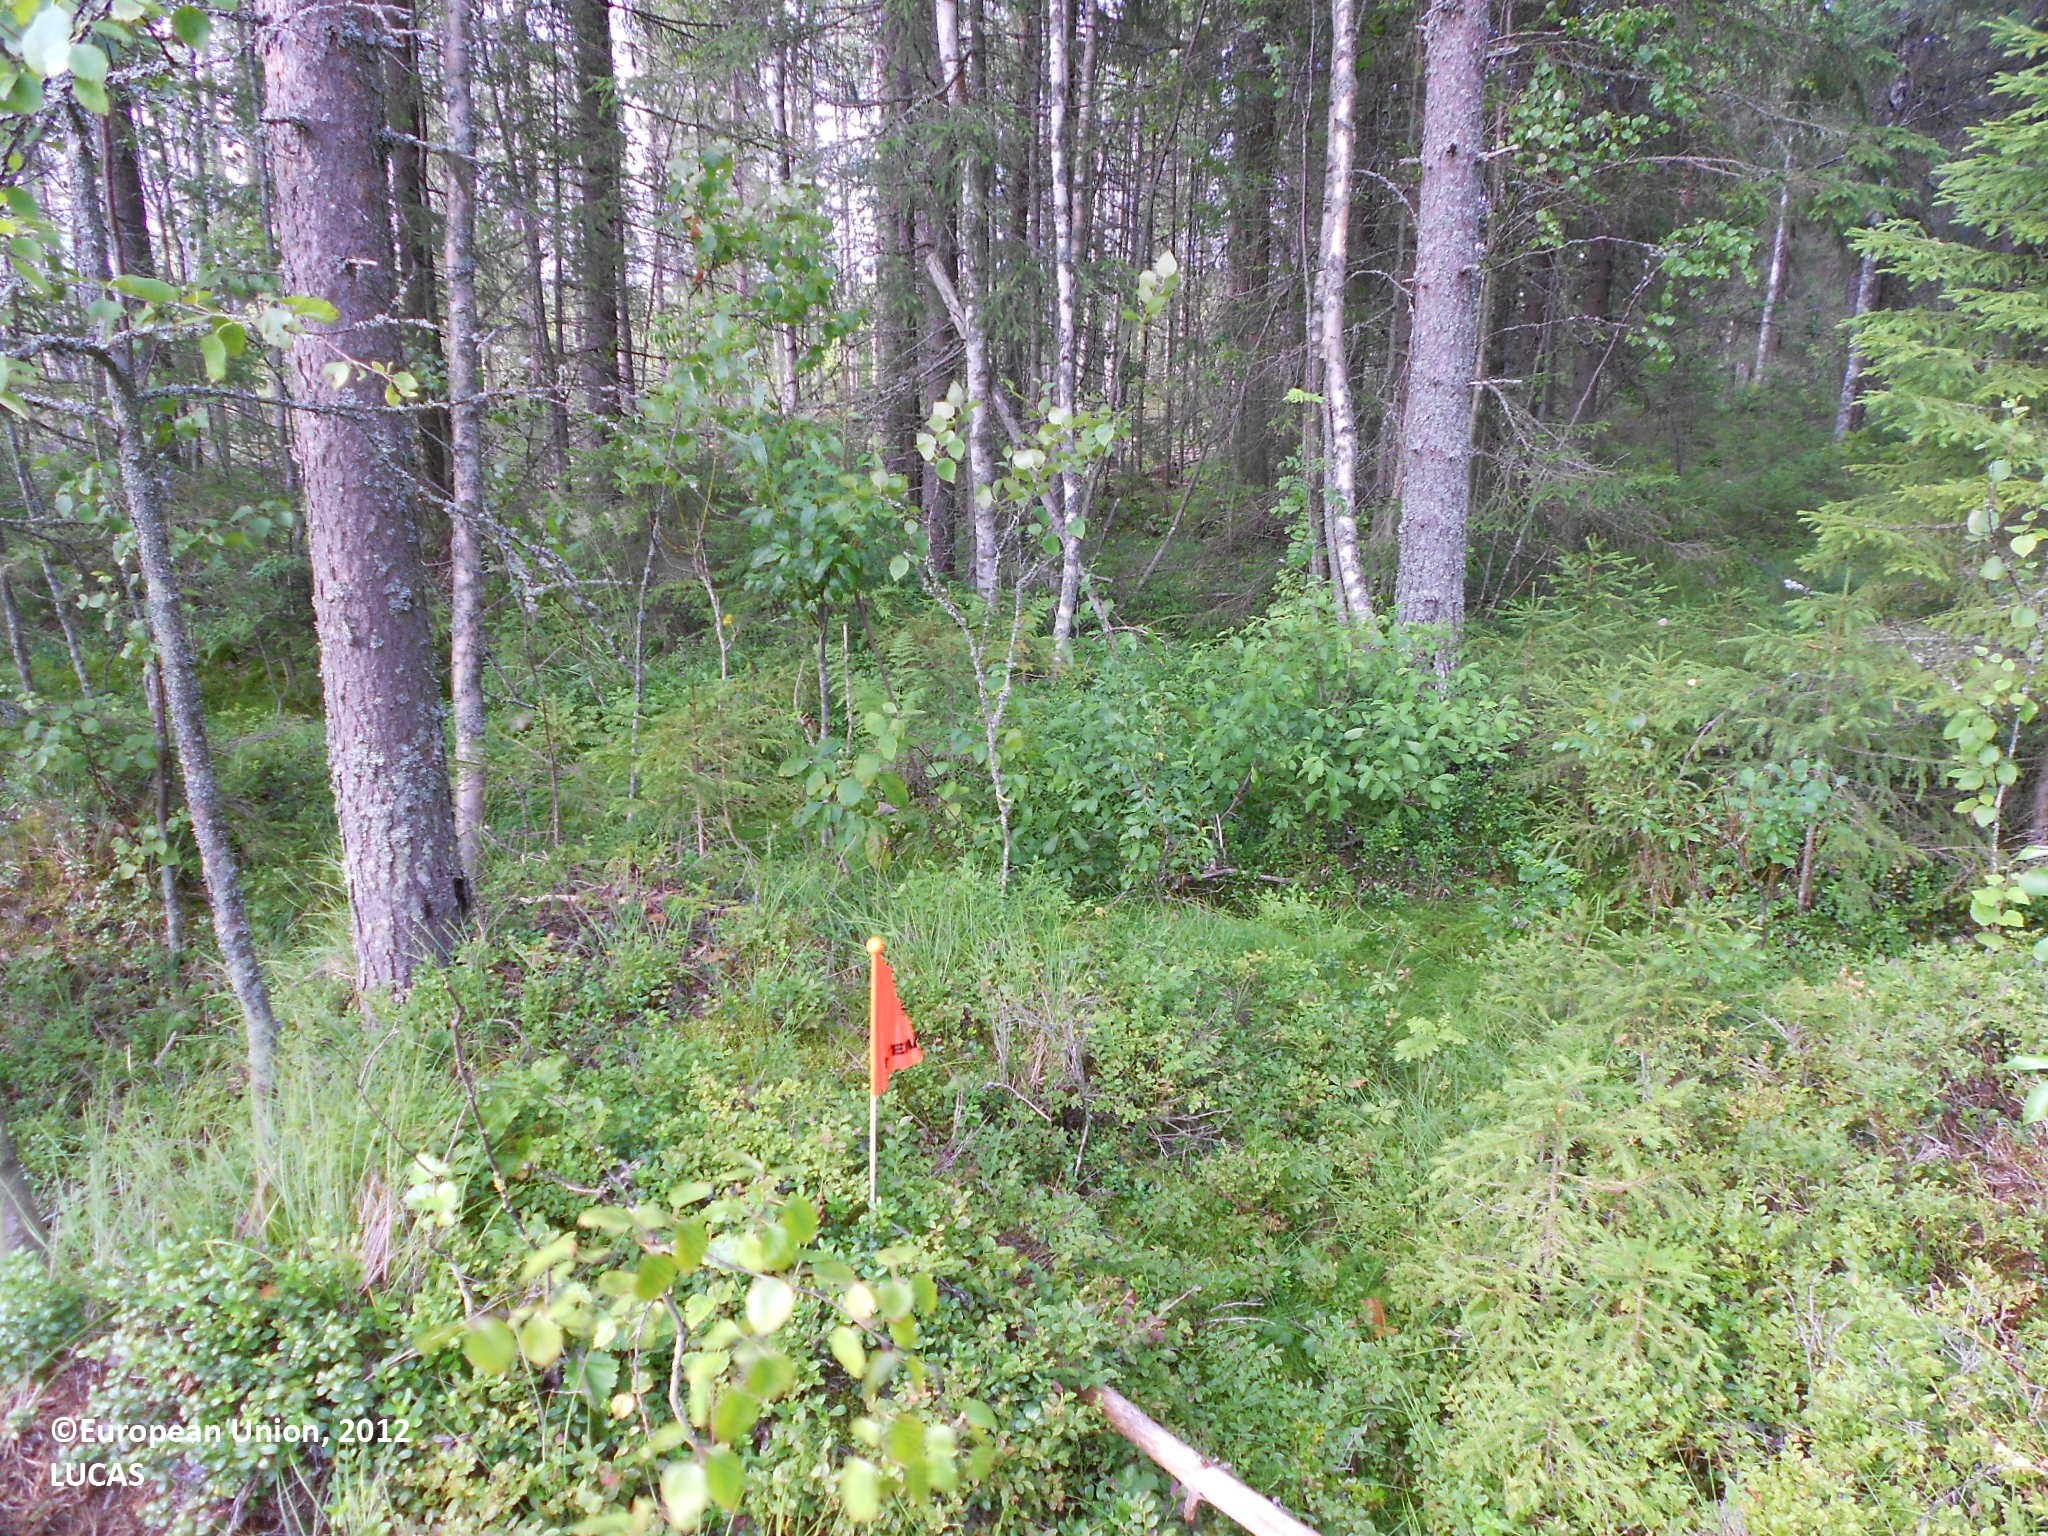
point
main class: Woodland
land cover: Spruce dominated coniferous woodland
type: boreal forest
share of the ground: > 75 %
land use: Forestry
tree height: > 5 m
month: August
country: FI
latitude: 63.4580
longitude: 28.8363
